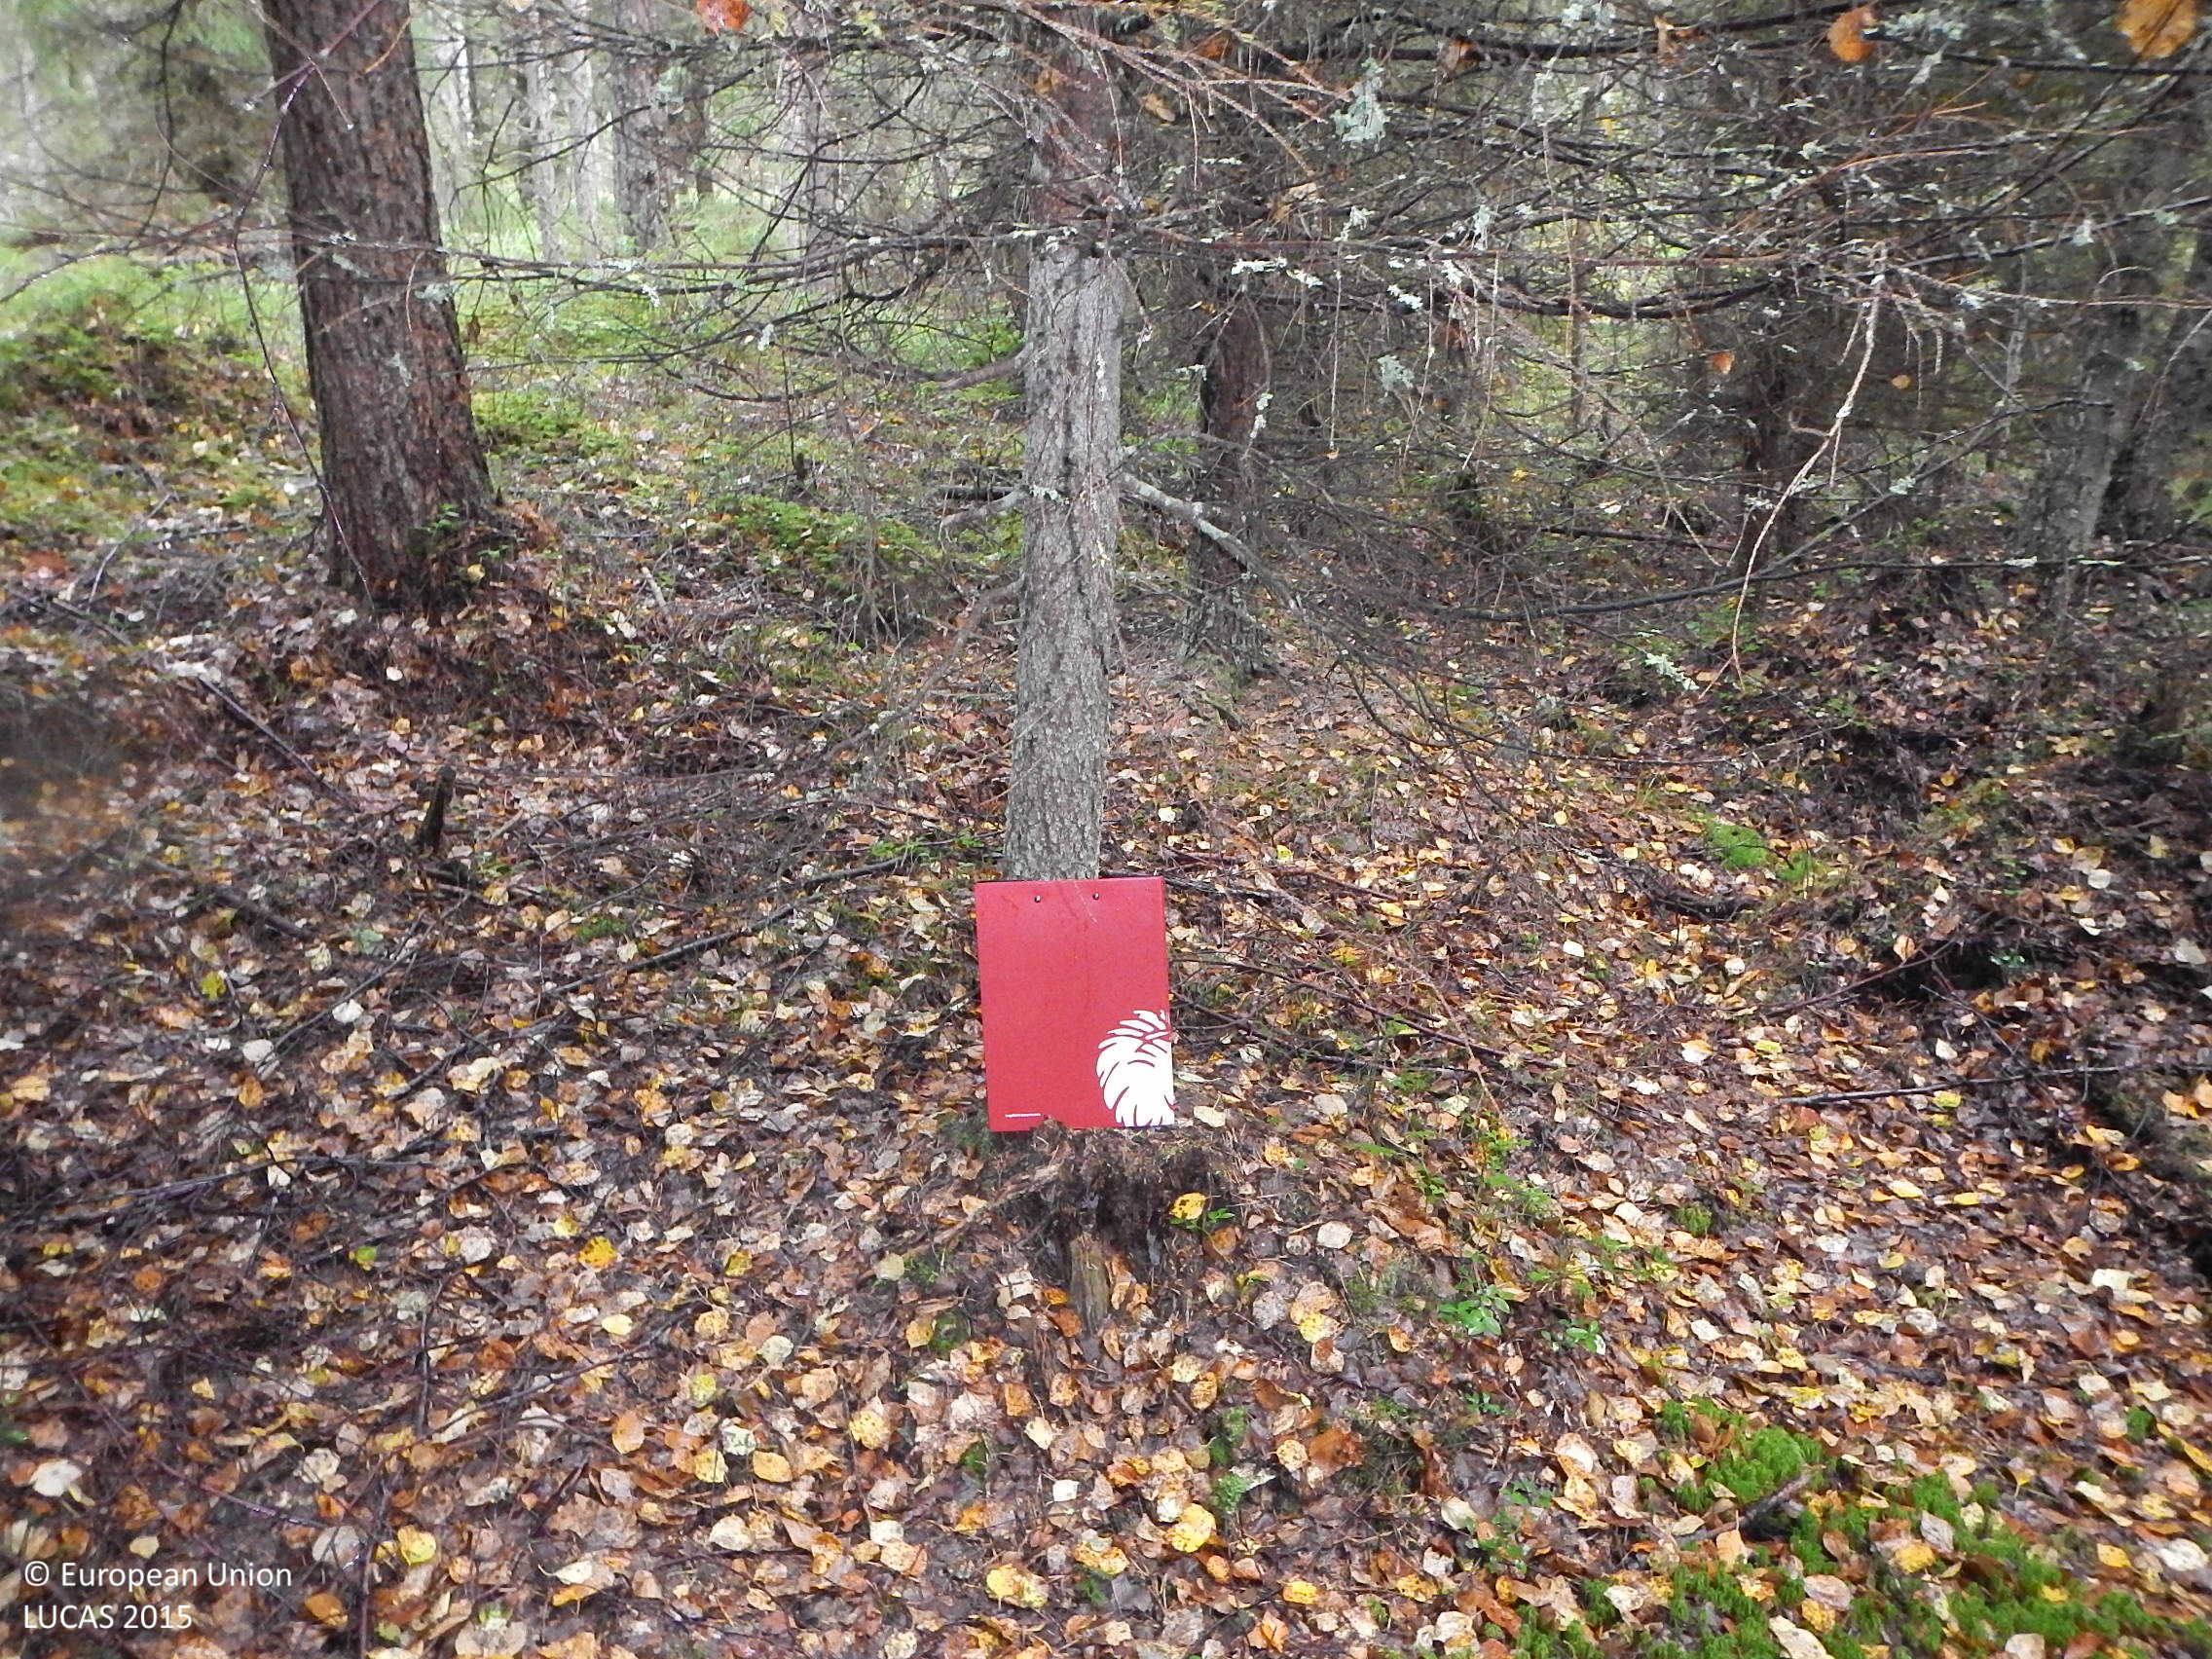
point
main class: Woodland
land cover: Other mixed woodland
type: boreal forest
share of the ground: > 75 %
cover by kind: coniferous forest trees 50 %, broadleaved forest trees 25 %, shrubs 10 %, unconsolidated bare surface 10 %, lichens and mosses 5 %
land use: Forestry
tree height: > 5 m
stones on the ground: 10 - 25 %
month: September
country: FI
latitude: 61.4148
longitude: 22.2575
